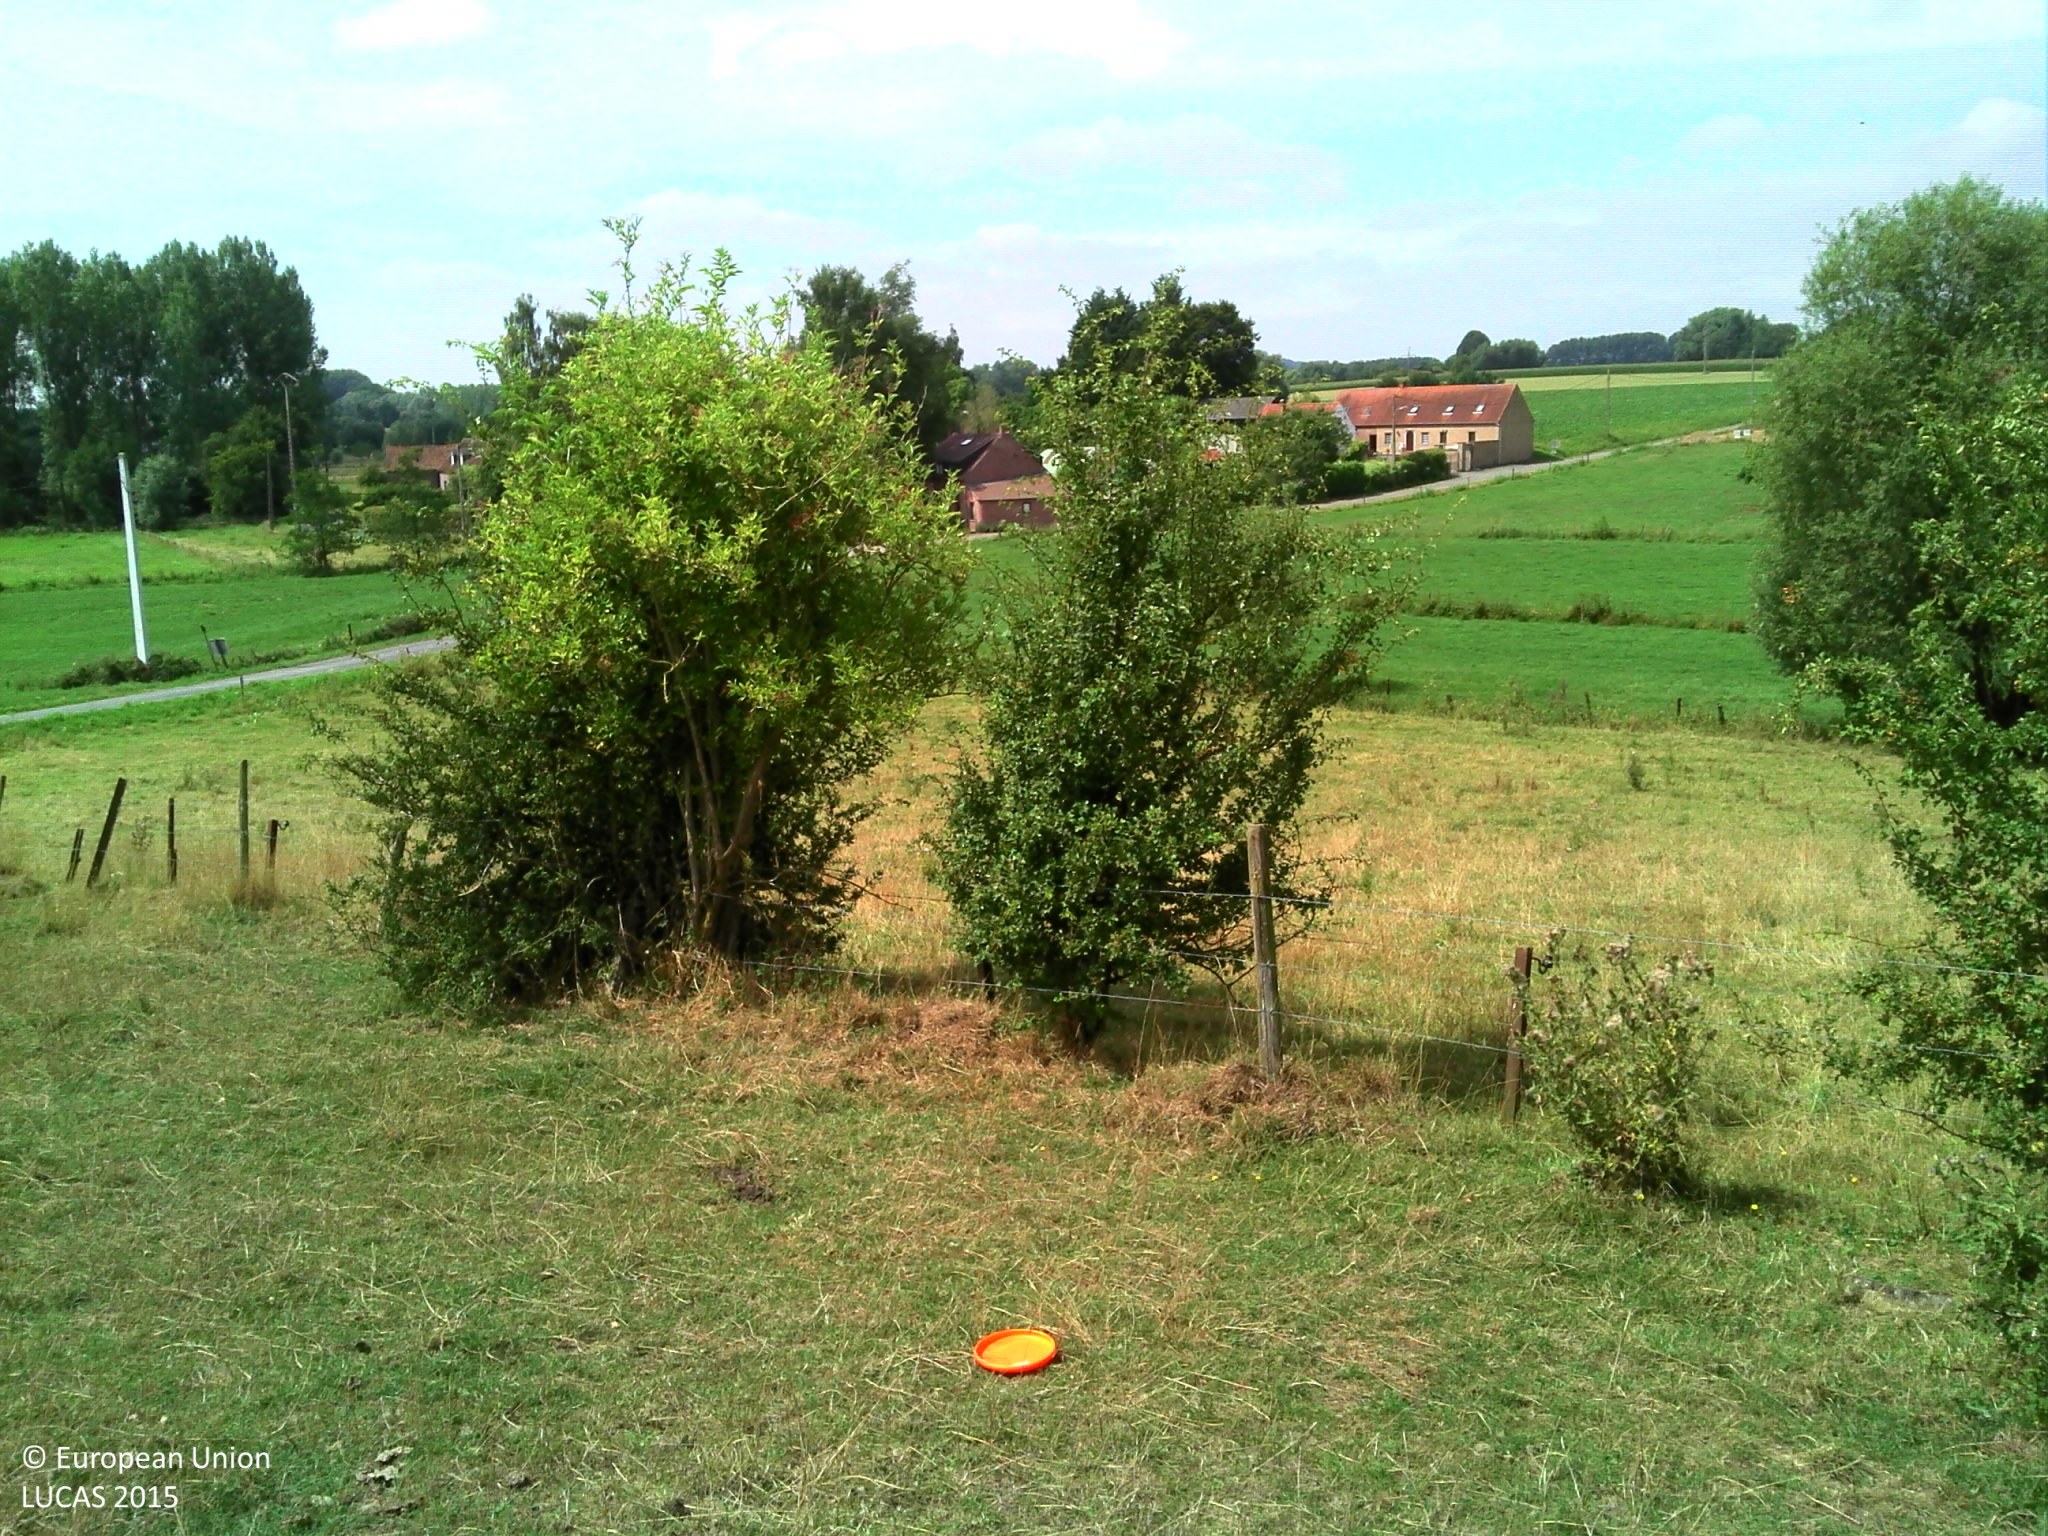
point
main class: Grassland
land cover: Grassland without tree/shrub cover
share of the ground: > 75 %
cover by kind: herbaceous plants 100 %
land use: Agriculture (excluding fallow land and kitchen gardens)
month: August
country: BE
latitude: 50.7354
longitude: 3.7731
